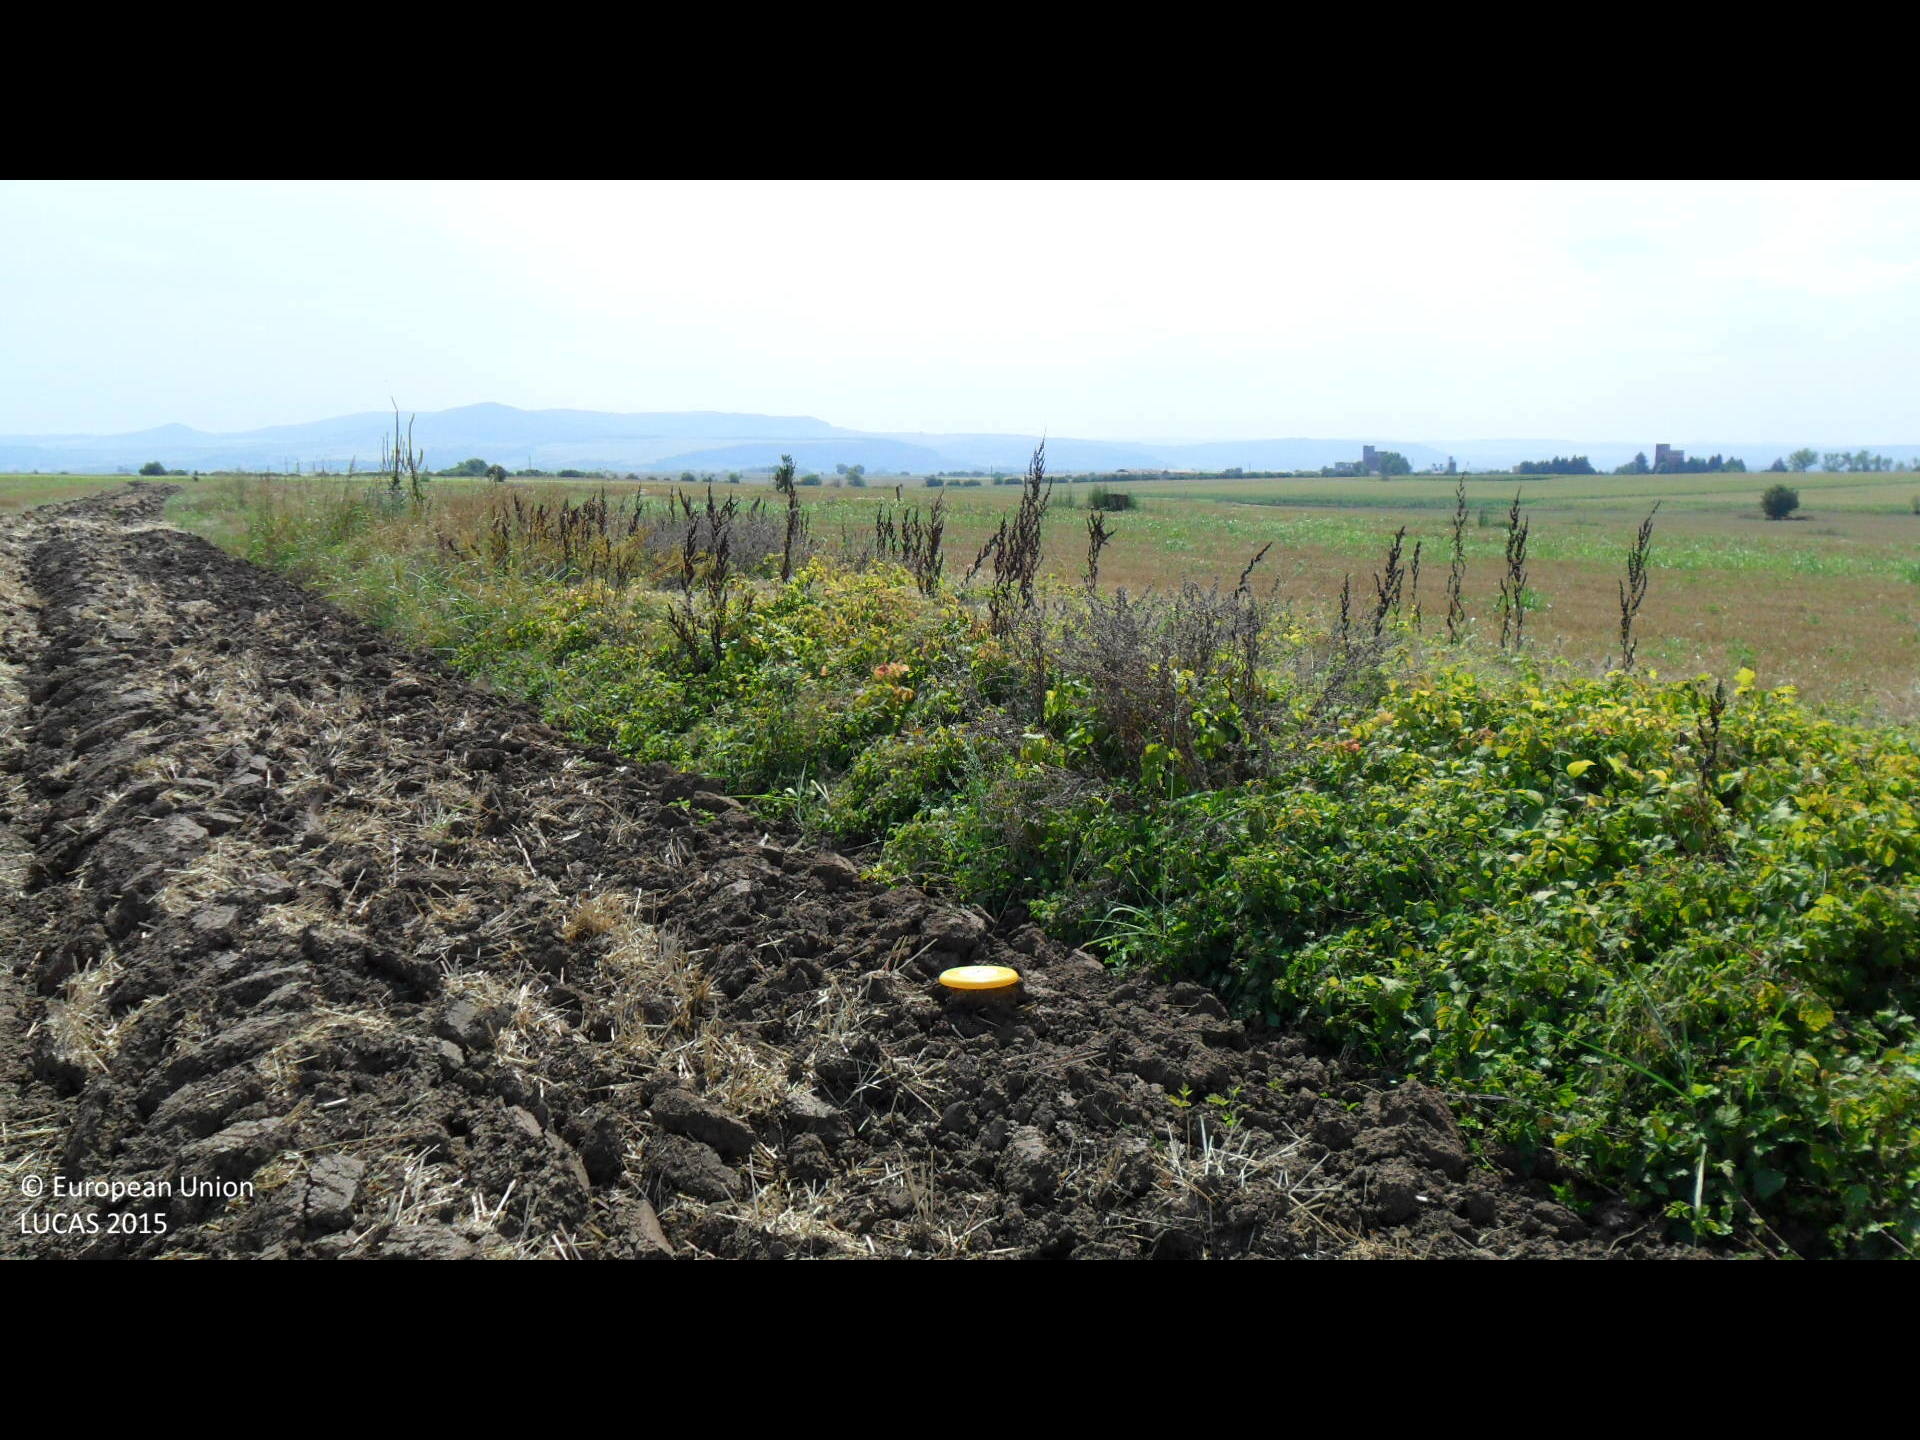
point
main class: Cropland
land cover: Barley
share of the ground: > 75 %
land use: Agriculture (excluding fallow land and kitchen gardens)
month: August
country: BG
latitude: 43.3752
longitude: 26.2277
